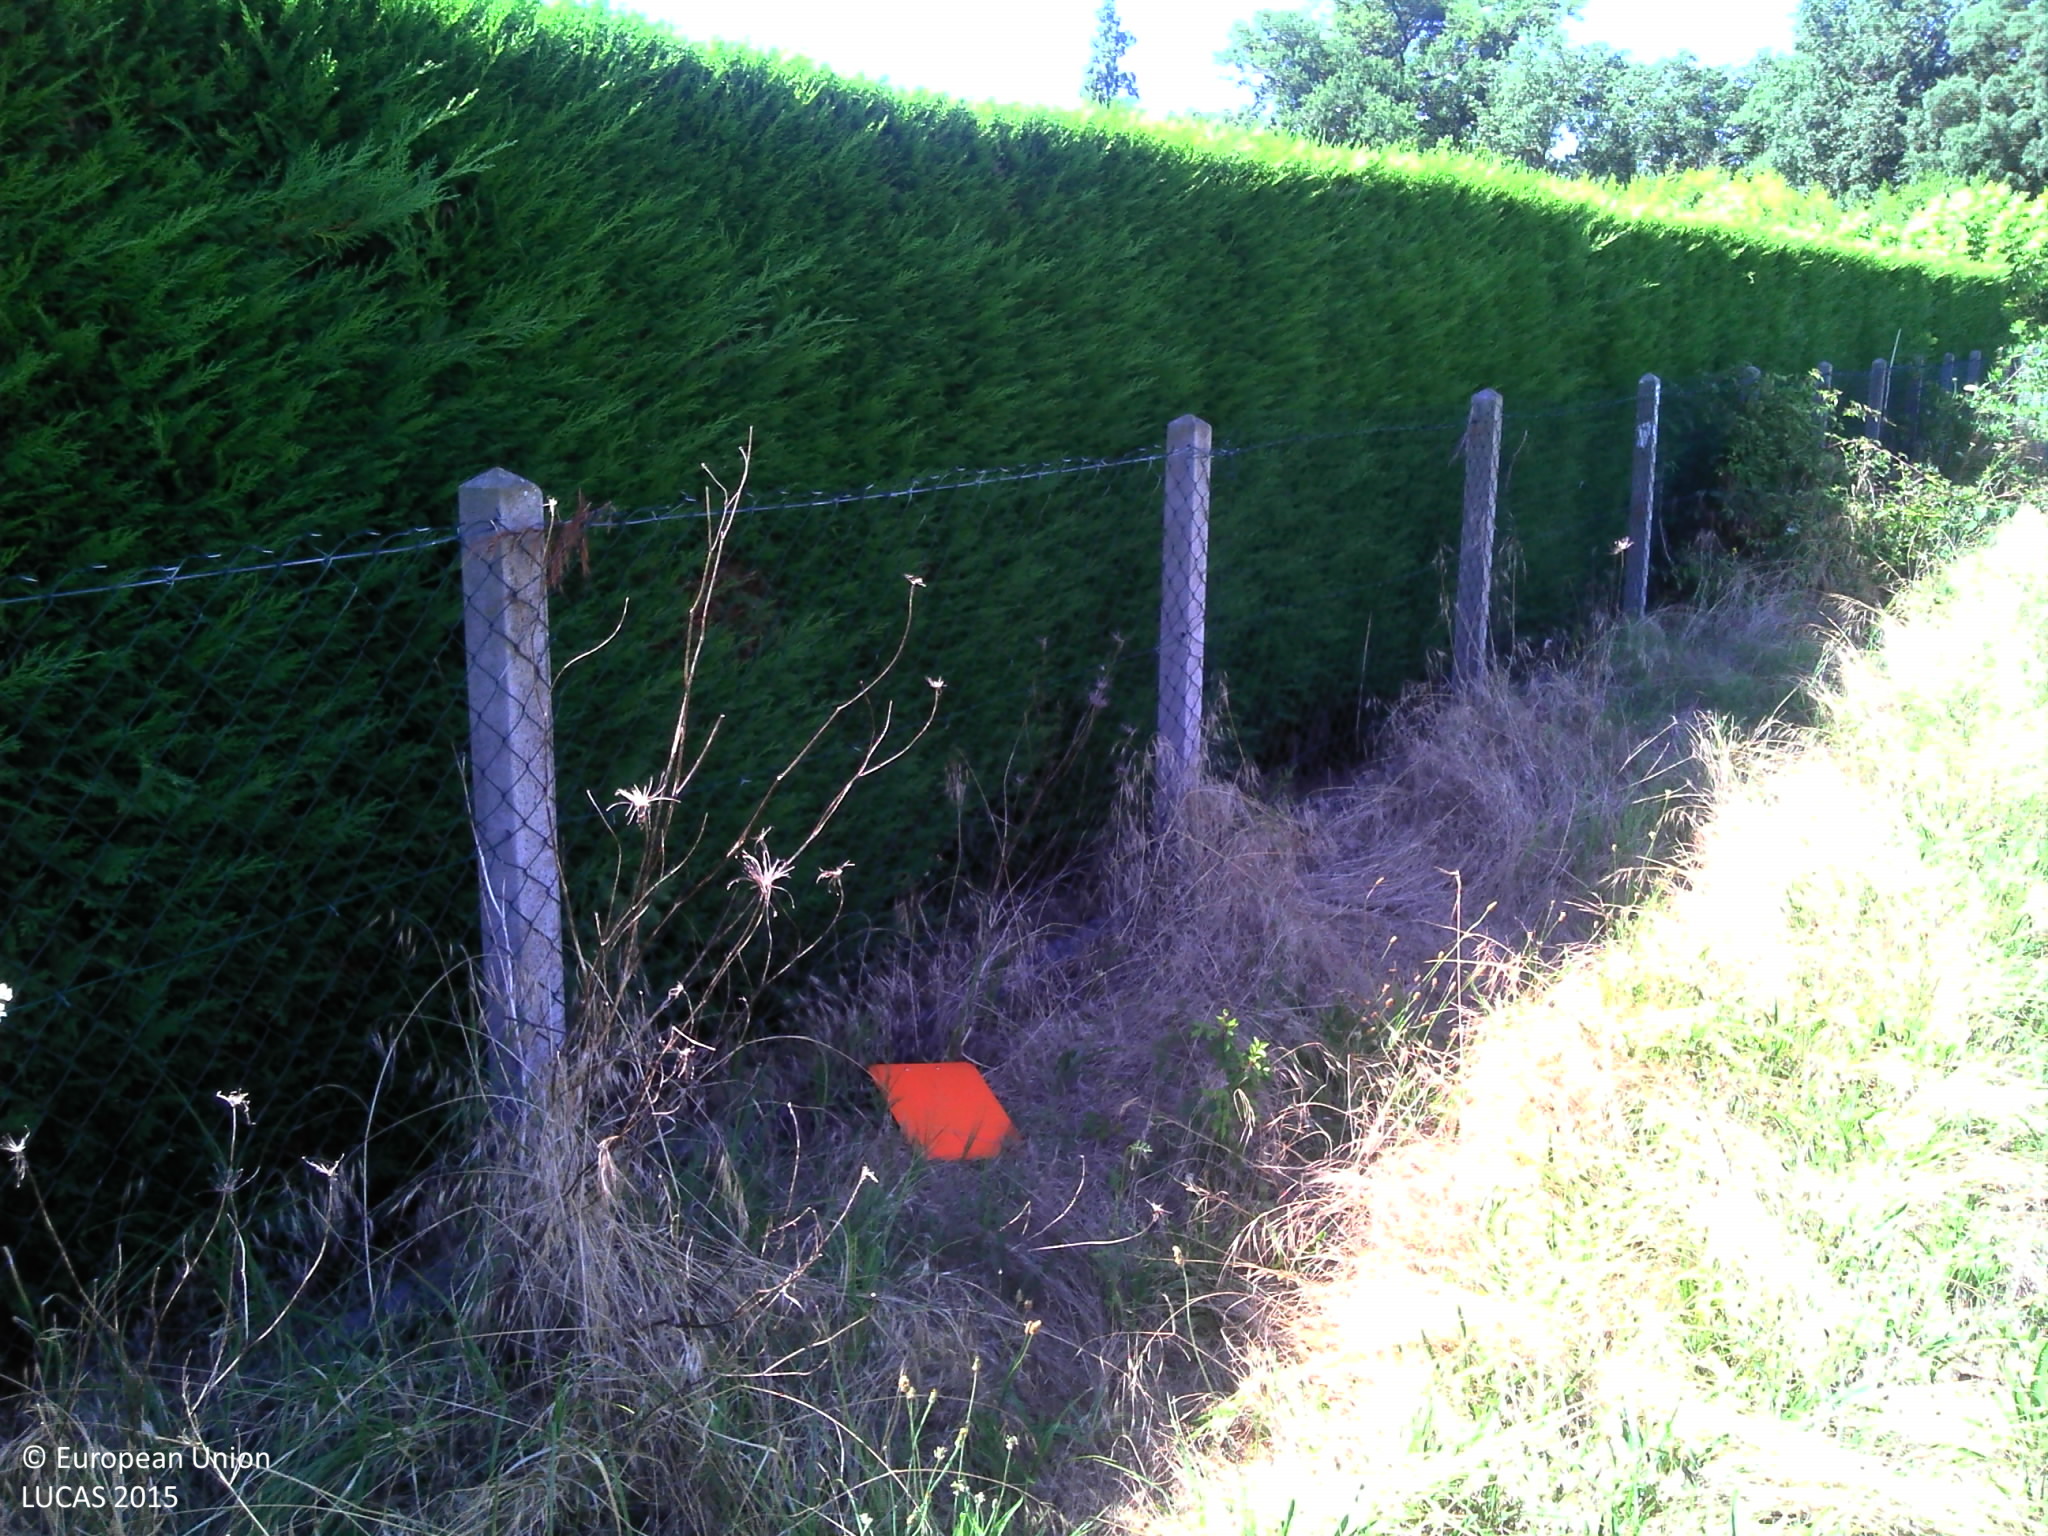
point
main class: Cropland
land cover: Floriculture and ornamental plants
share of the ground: > 75 %
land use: Agriculture (excluding fallow land and kitchen gardens)
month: July
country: FR
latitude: 44.0491
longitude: -0.5349
